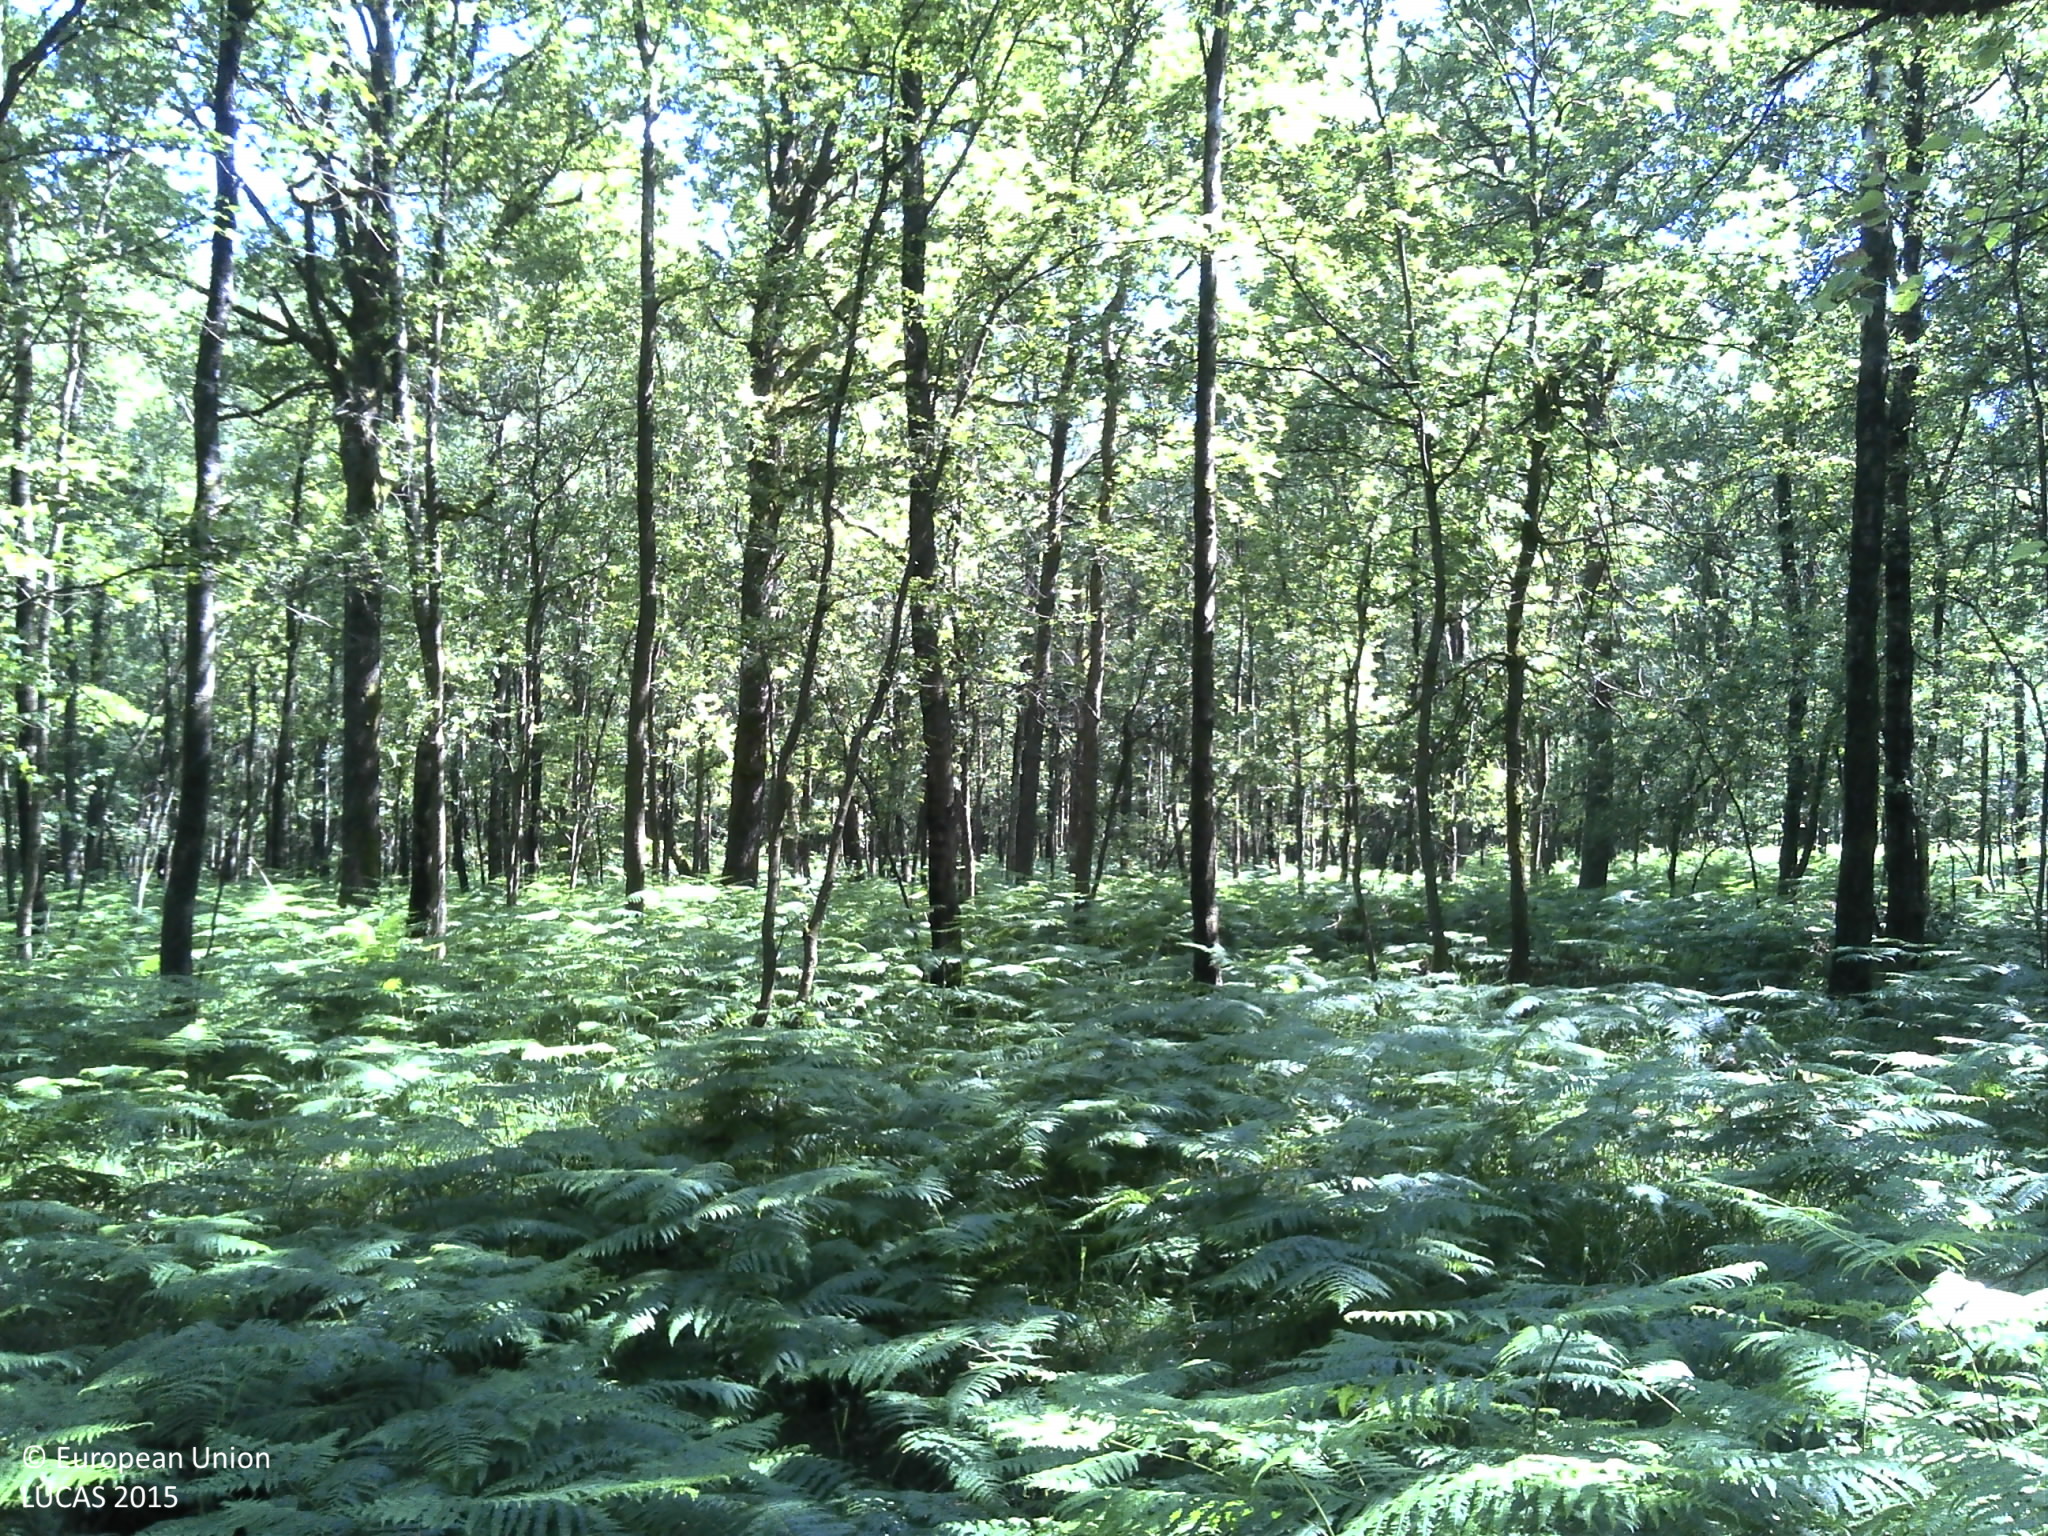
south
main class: Woodland
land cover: Broadleaved woodland
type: acidophilous oak and oak-birch forest
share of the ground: 25 - 50 %
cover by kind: broadleaved forest trees 65 %, herbaceous plants 25 %, consolidated bare surface 10 %
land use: Forestry
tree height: > 5 m
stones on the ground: 10 - 25 %
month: June
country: FR
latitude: 49.9933
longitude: 4.7938
